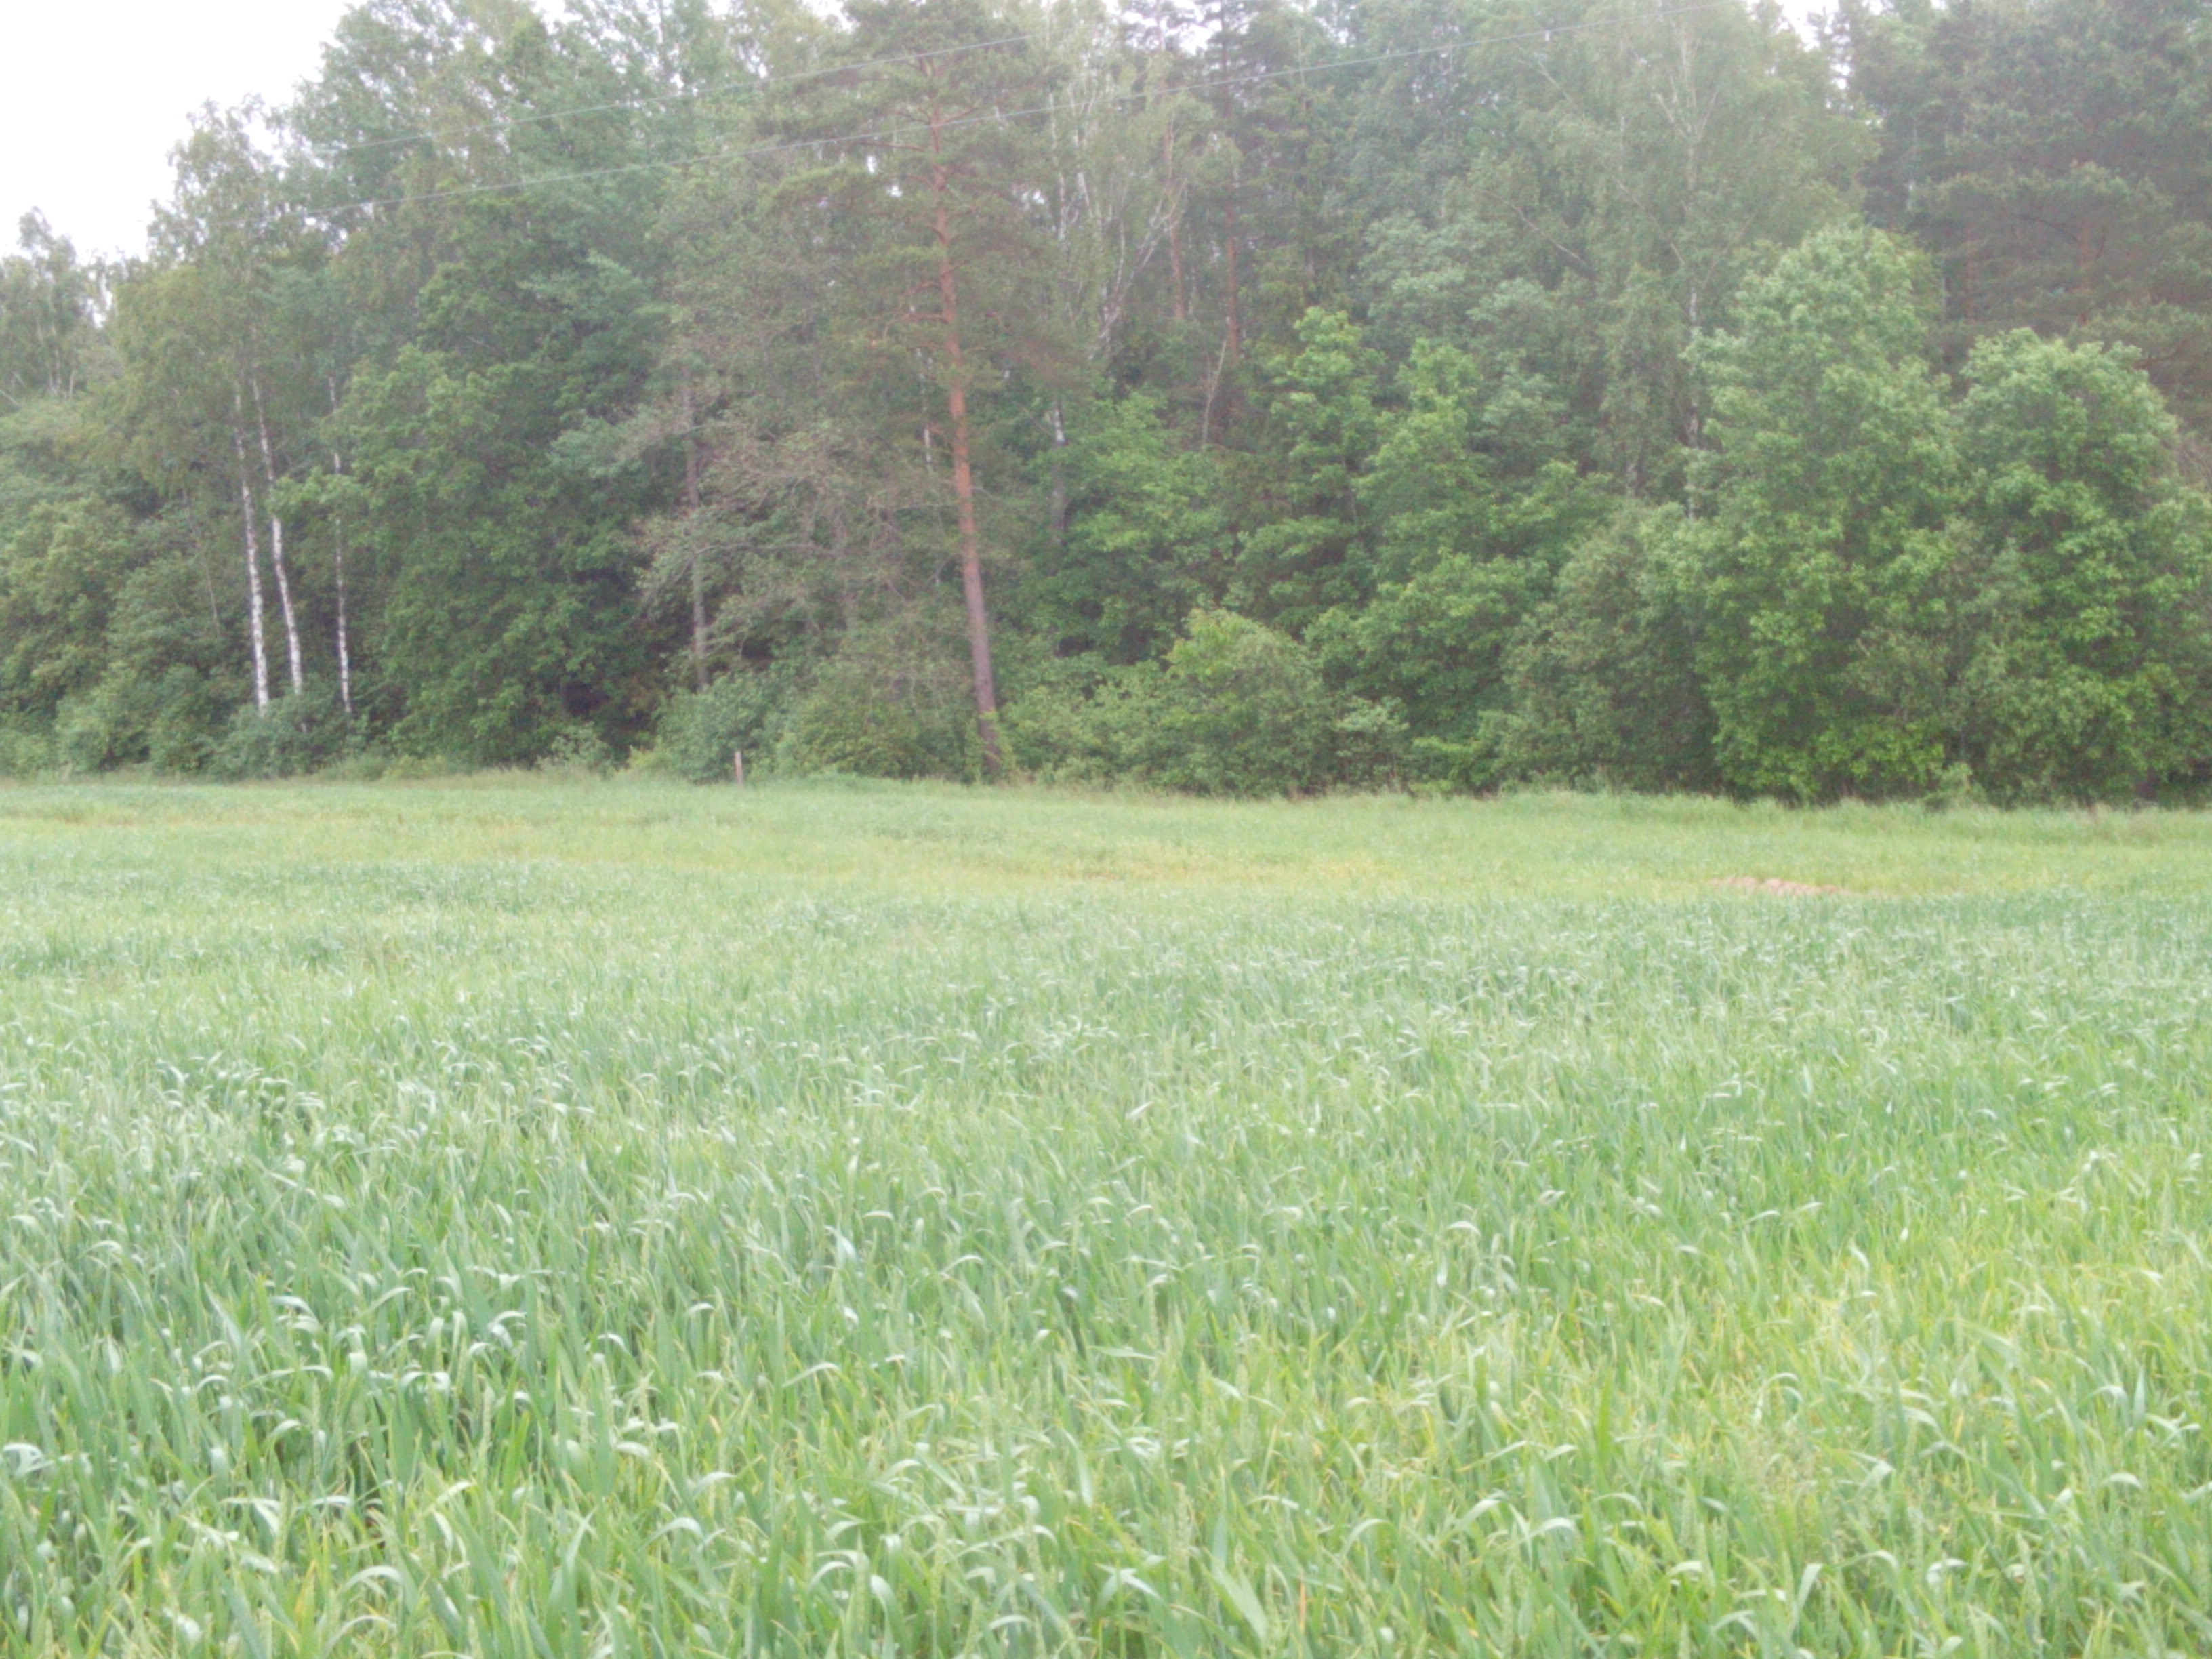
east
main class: Cropland
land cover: Common wheat
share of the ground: > 75 %
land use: Agriculture (excluding fallow land and kitchen gardens)
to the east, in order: Common wheat; Electric lines; Common wheat; Spruce dominated mixed woodland; Broadleaved woodland; Shruby margins; Common wheat
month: June
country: LV
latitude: 56.8066
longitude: 21.9873
